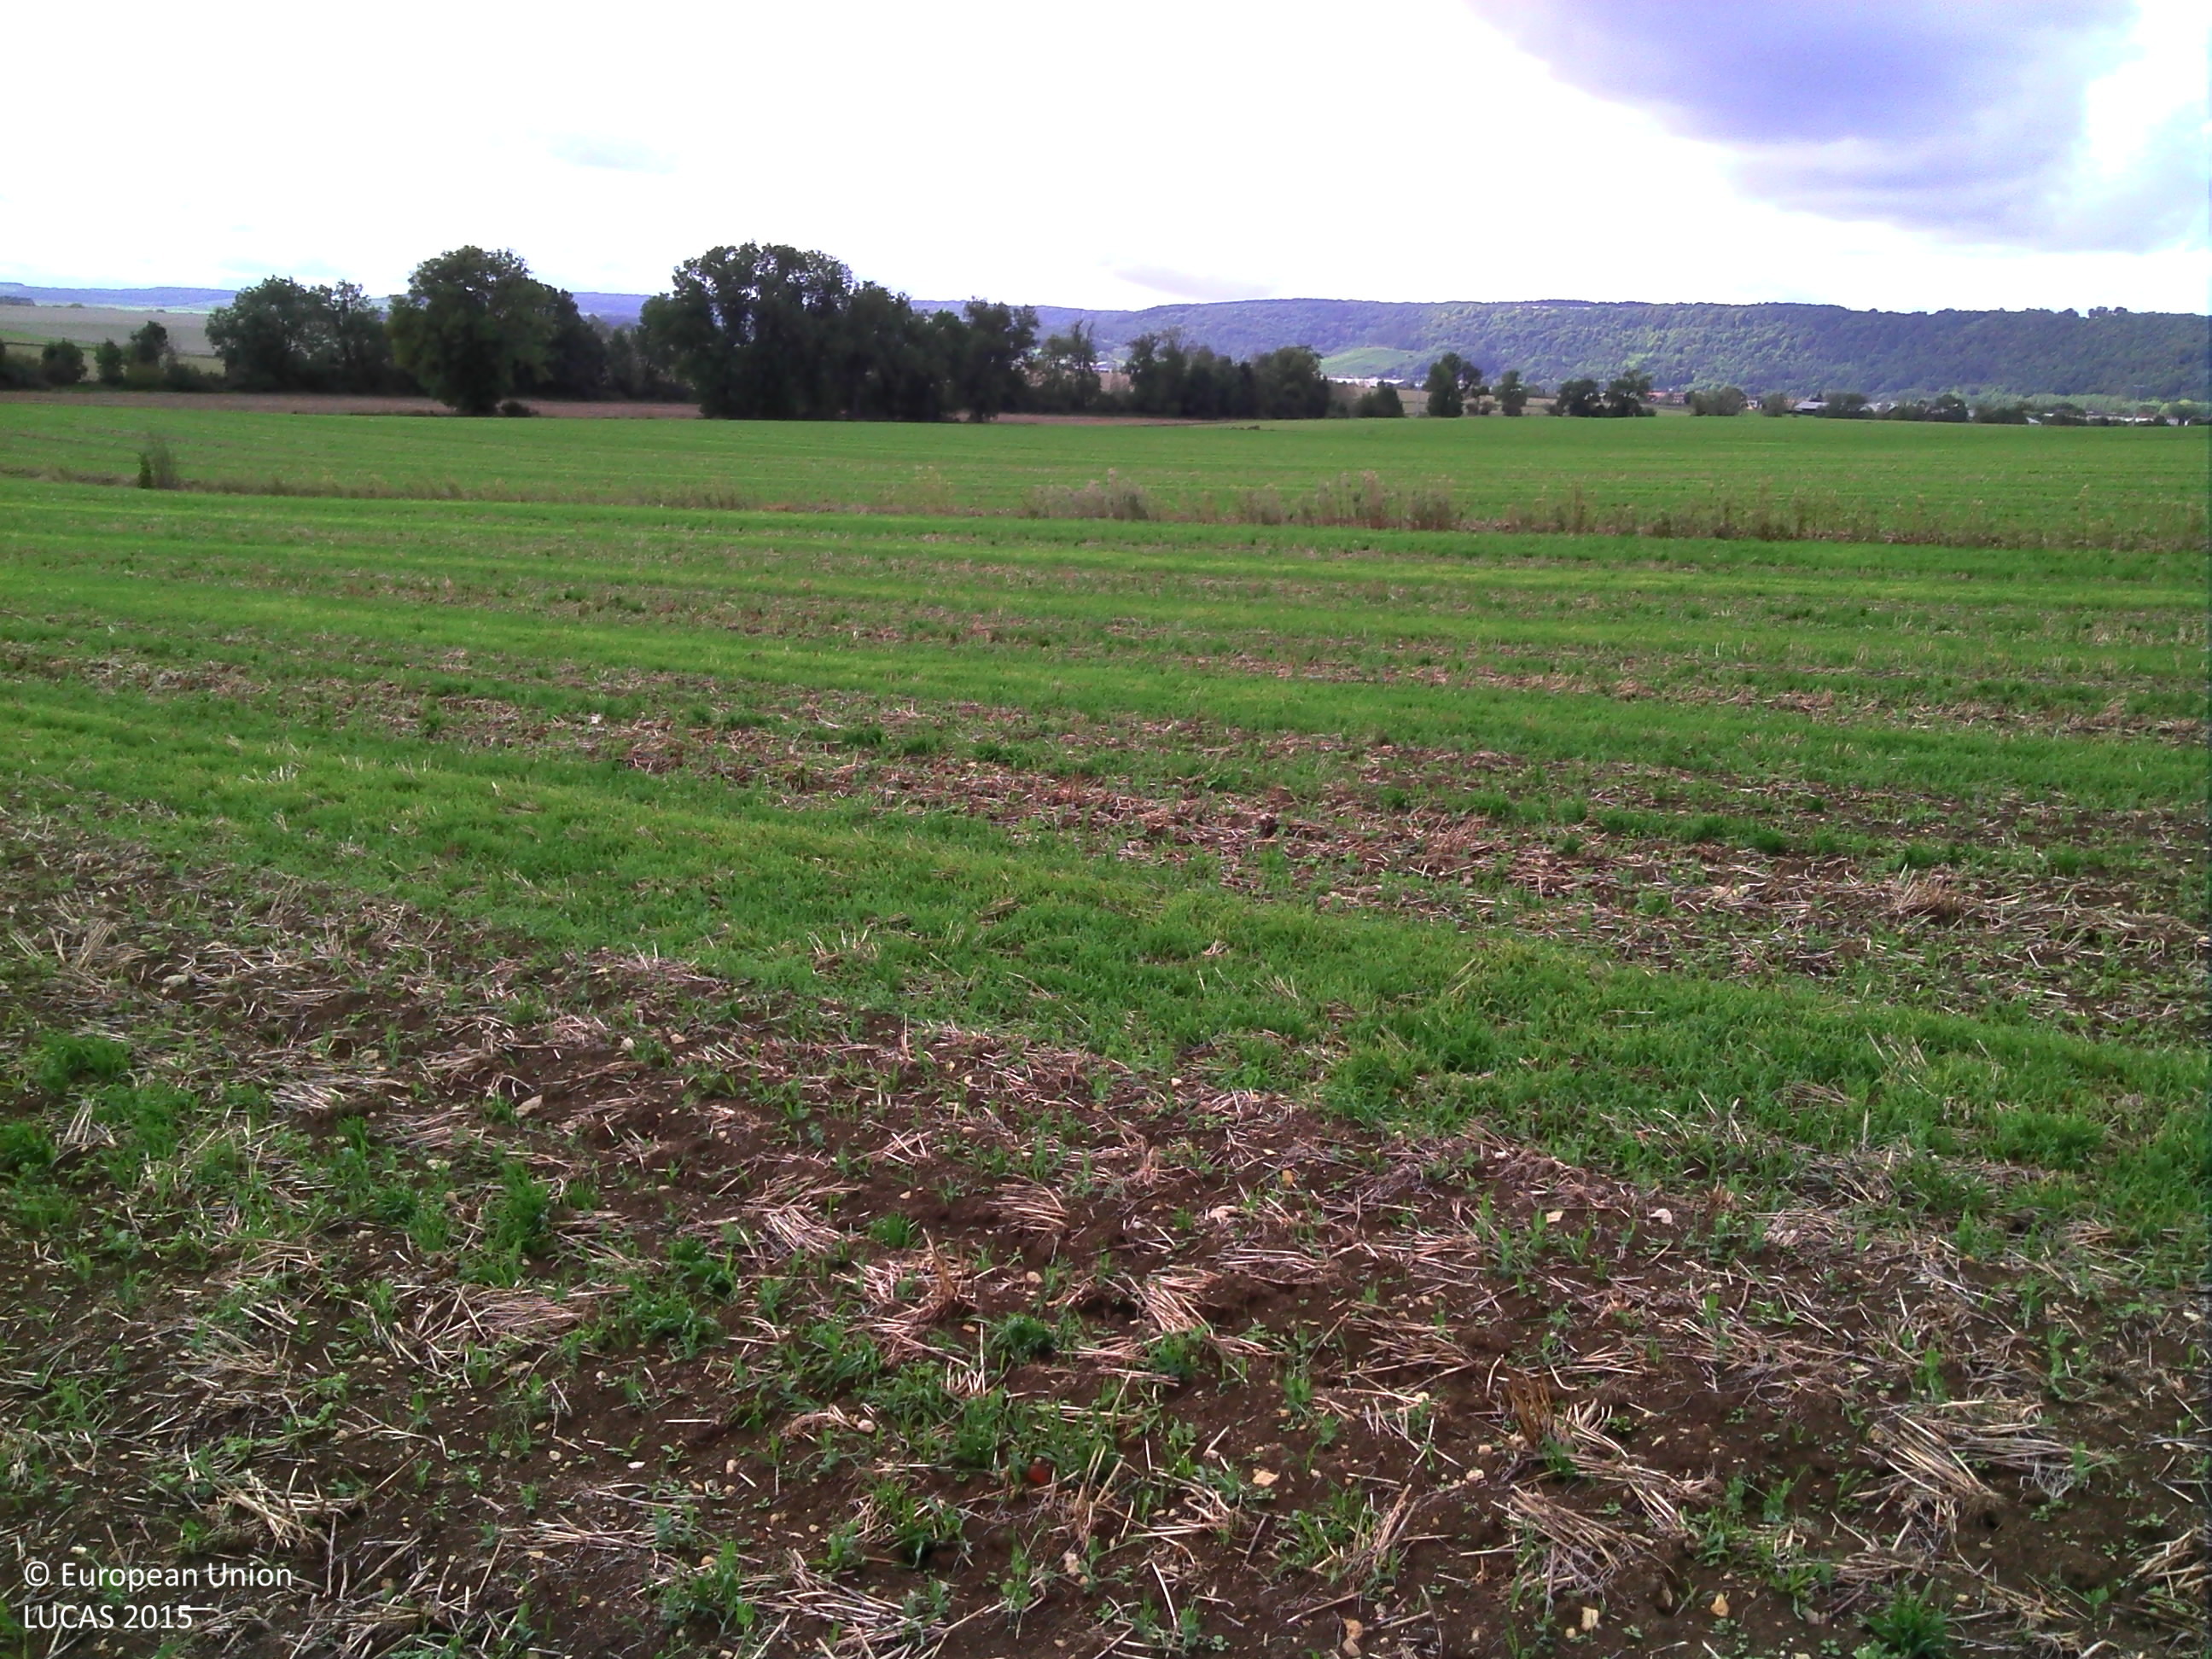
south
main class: Cropland
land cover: Other fibre and oleaginous crops
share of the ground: > 75 %
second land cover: Other leguminous and mixtures for fodder
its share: 10 - 25 %
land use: Agriculture (excluding fallow land and kitchen gardens)
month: September
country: FR
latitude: 48.2420
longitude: 4.7332
